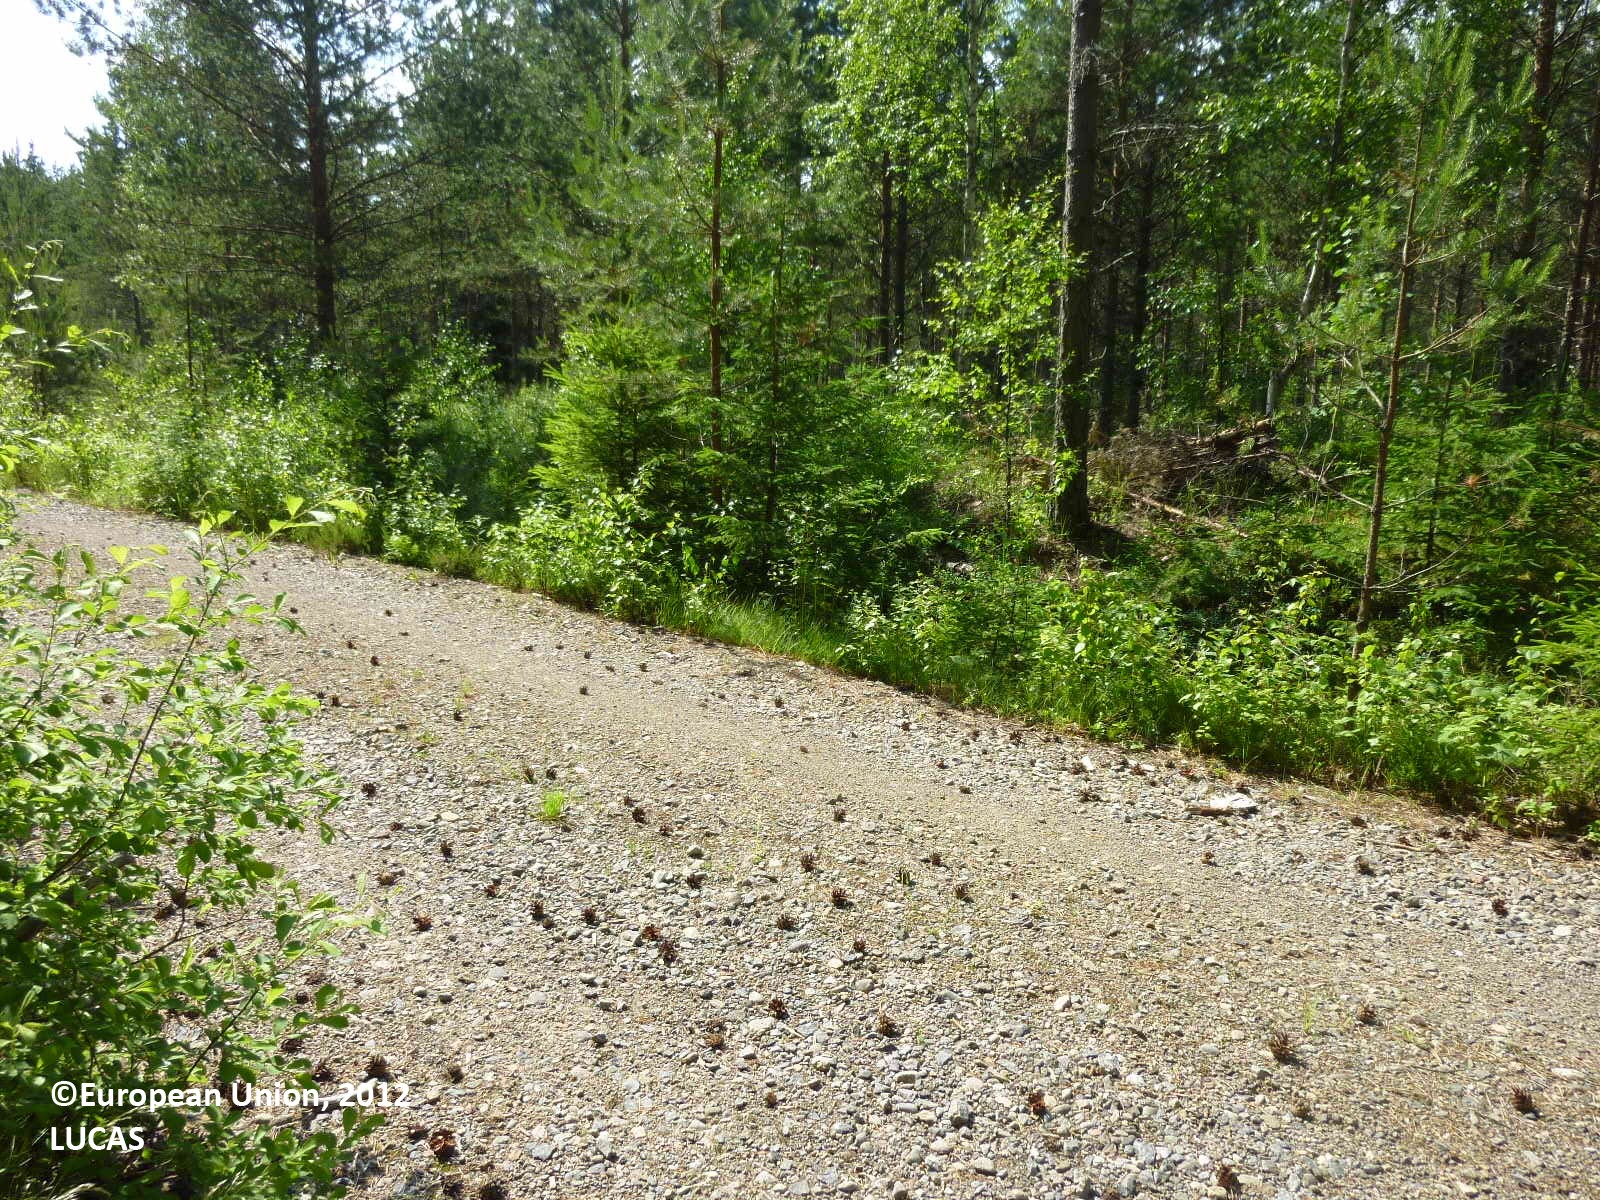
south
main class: Artificial land
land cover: Non built-up linear features
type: boreal forest
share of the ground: > 75 %
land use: Road transport
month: July
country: FI
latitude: 61.2337
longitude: 22.4521
